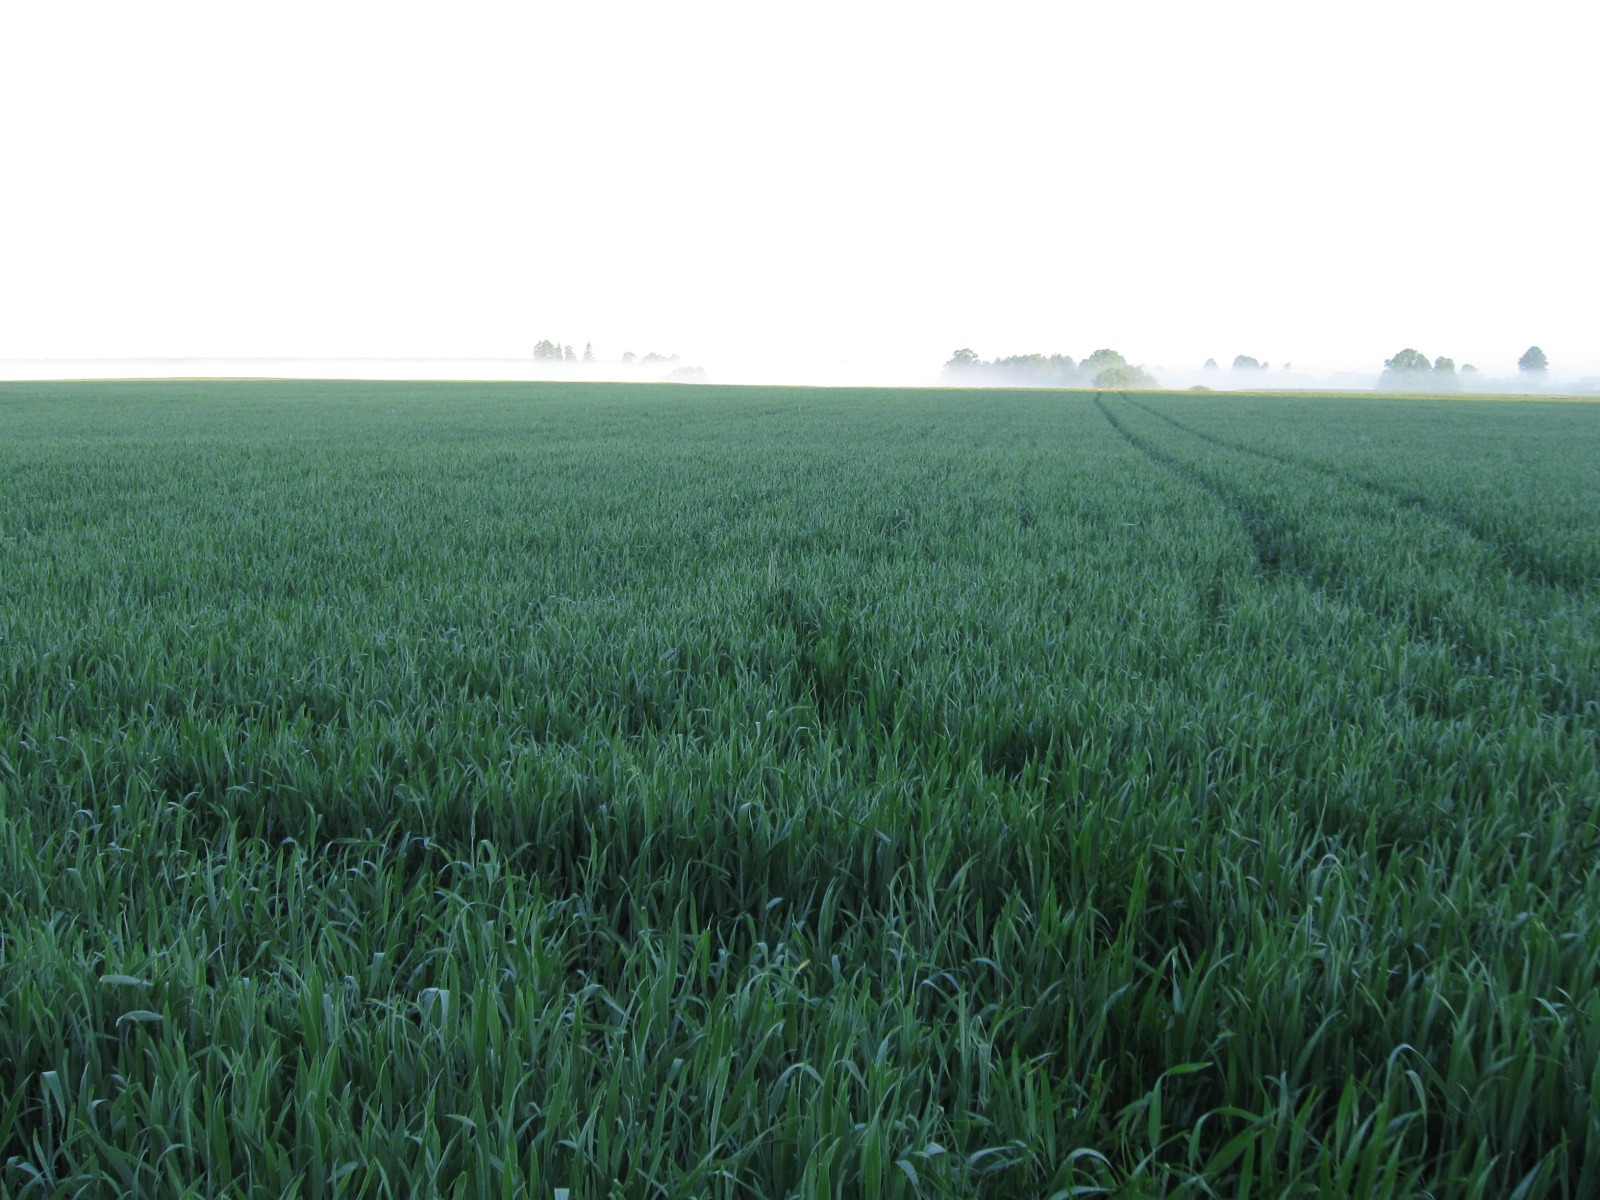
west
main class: Cropland
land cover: Common wheat
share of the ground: > 75 %
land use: Agriculture (excluding fallow land and kitchen gardens)
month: June
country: LT
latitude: 54.4685
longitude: 23.8049
